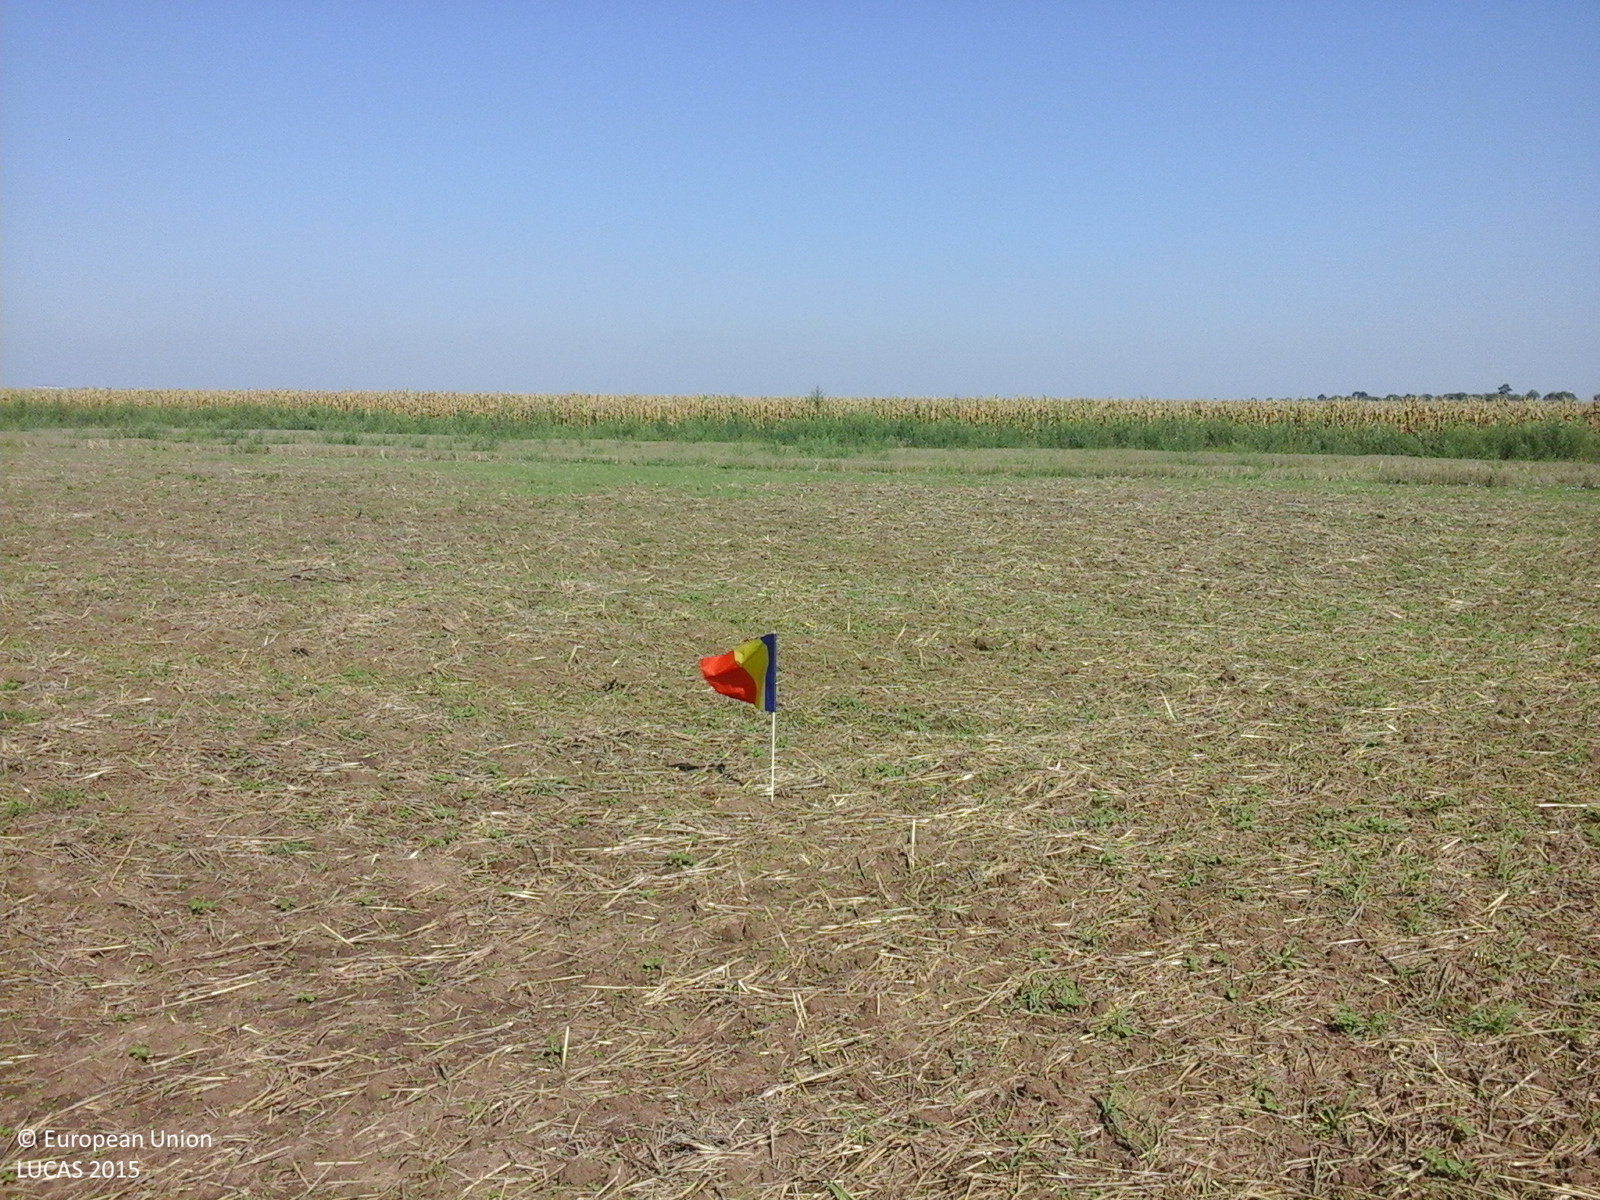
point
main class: Cropland
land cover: Common wheat
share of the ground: 10 - 25 %
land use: Agriculture (excluding fallow land and kitchen gardens)
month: August
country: RO
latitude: 45.8879
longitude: 21.2035
